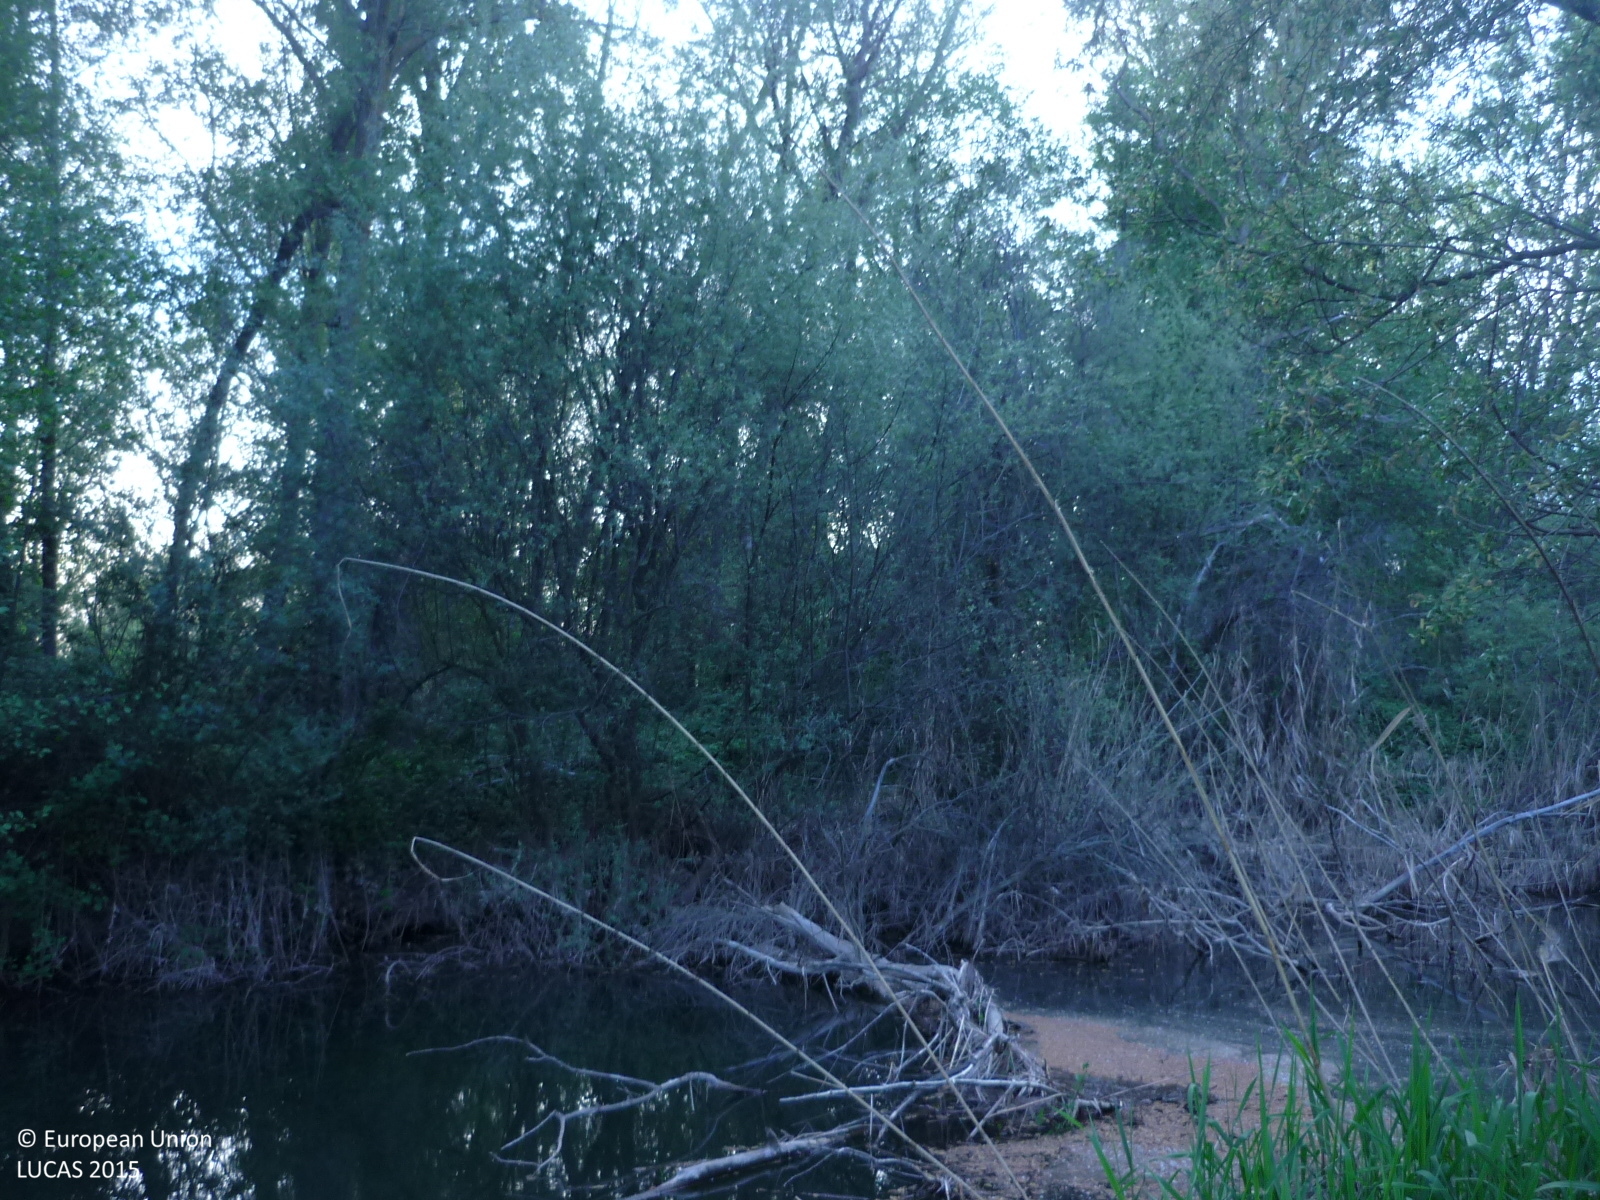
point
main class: Woodland
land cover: Broadleaved woodland
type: floodplain forest
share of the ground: > 75 %
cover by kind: broadleaved forest trees 90 %, herbaceous plants 10 %
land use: Semi-natural and natural areas not in use
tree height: > 5 m
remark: Temporary flooded
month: April
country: ES
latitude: 40.6970
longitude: -3.5421
